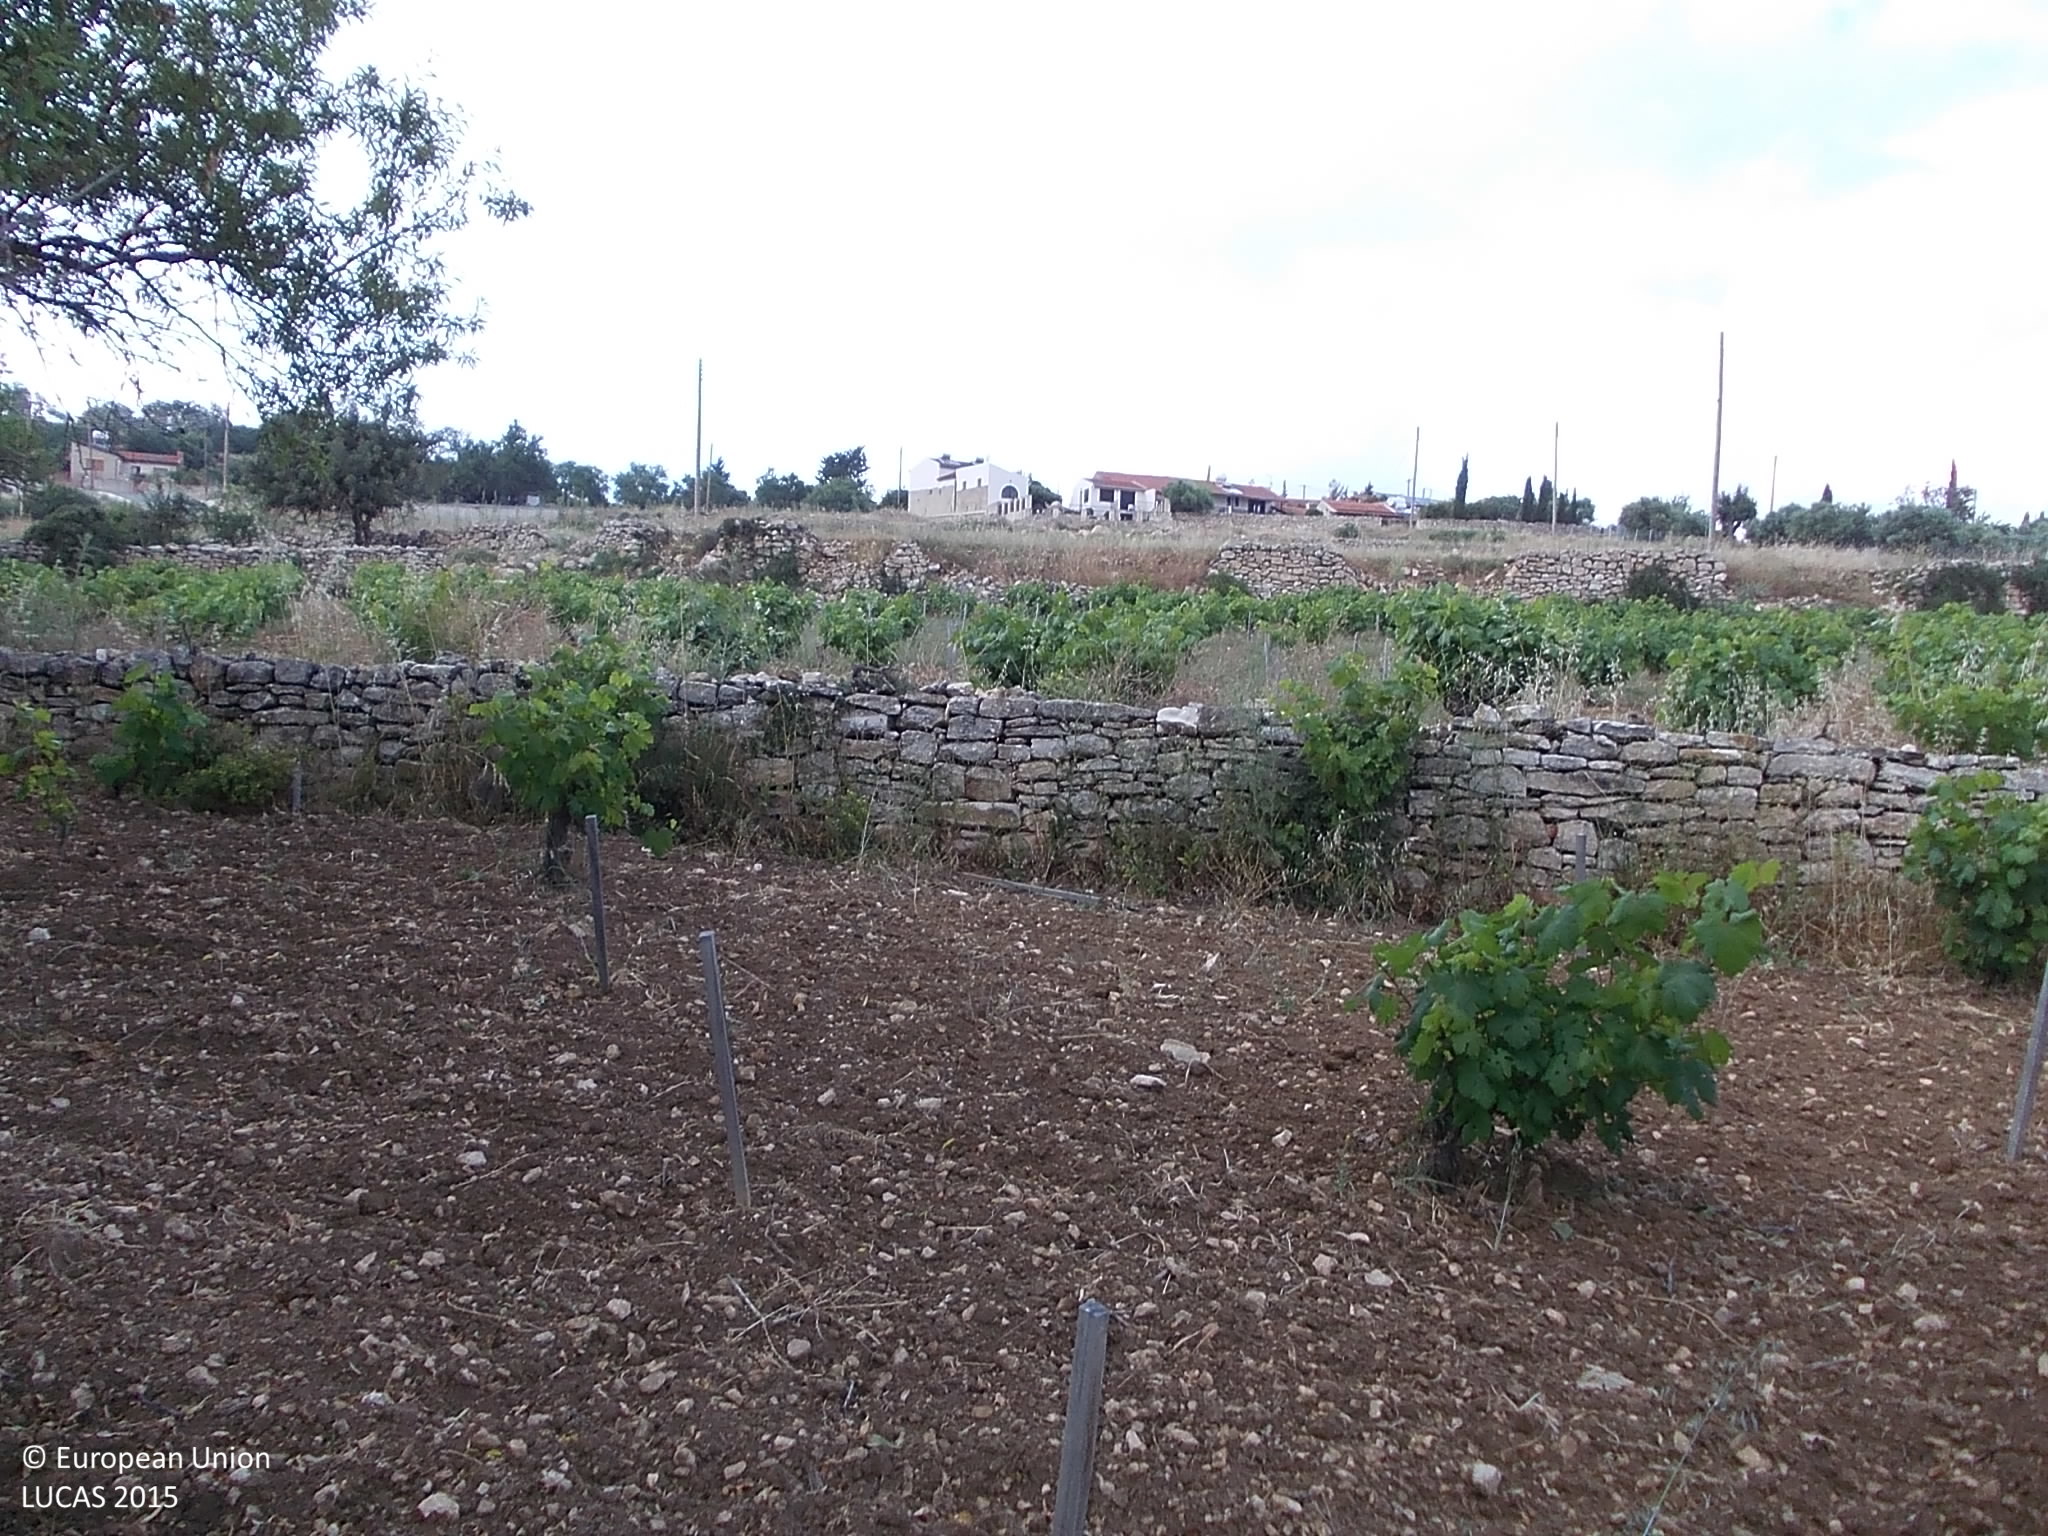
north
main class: Cropland
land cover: Vineyards
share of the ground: < 10 %
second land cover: Nuts trees
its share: < 10 %
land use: Agriculture (excluding fallow land and kitchen gardens)
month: May
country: CY
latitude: 34.7731
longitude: 32.7873
